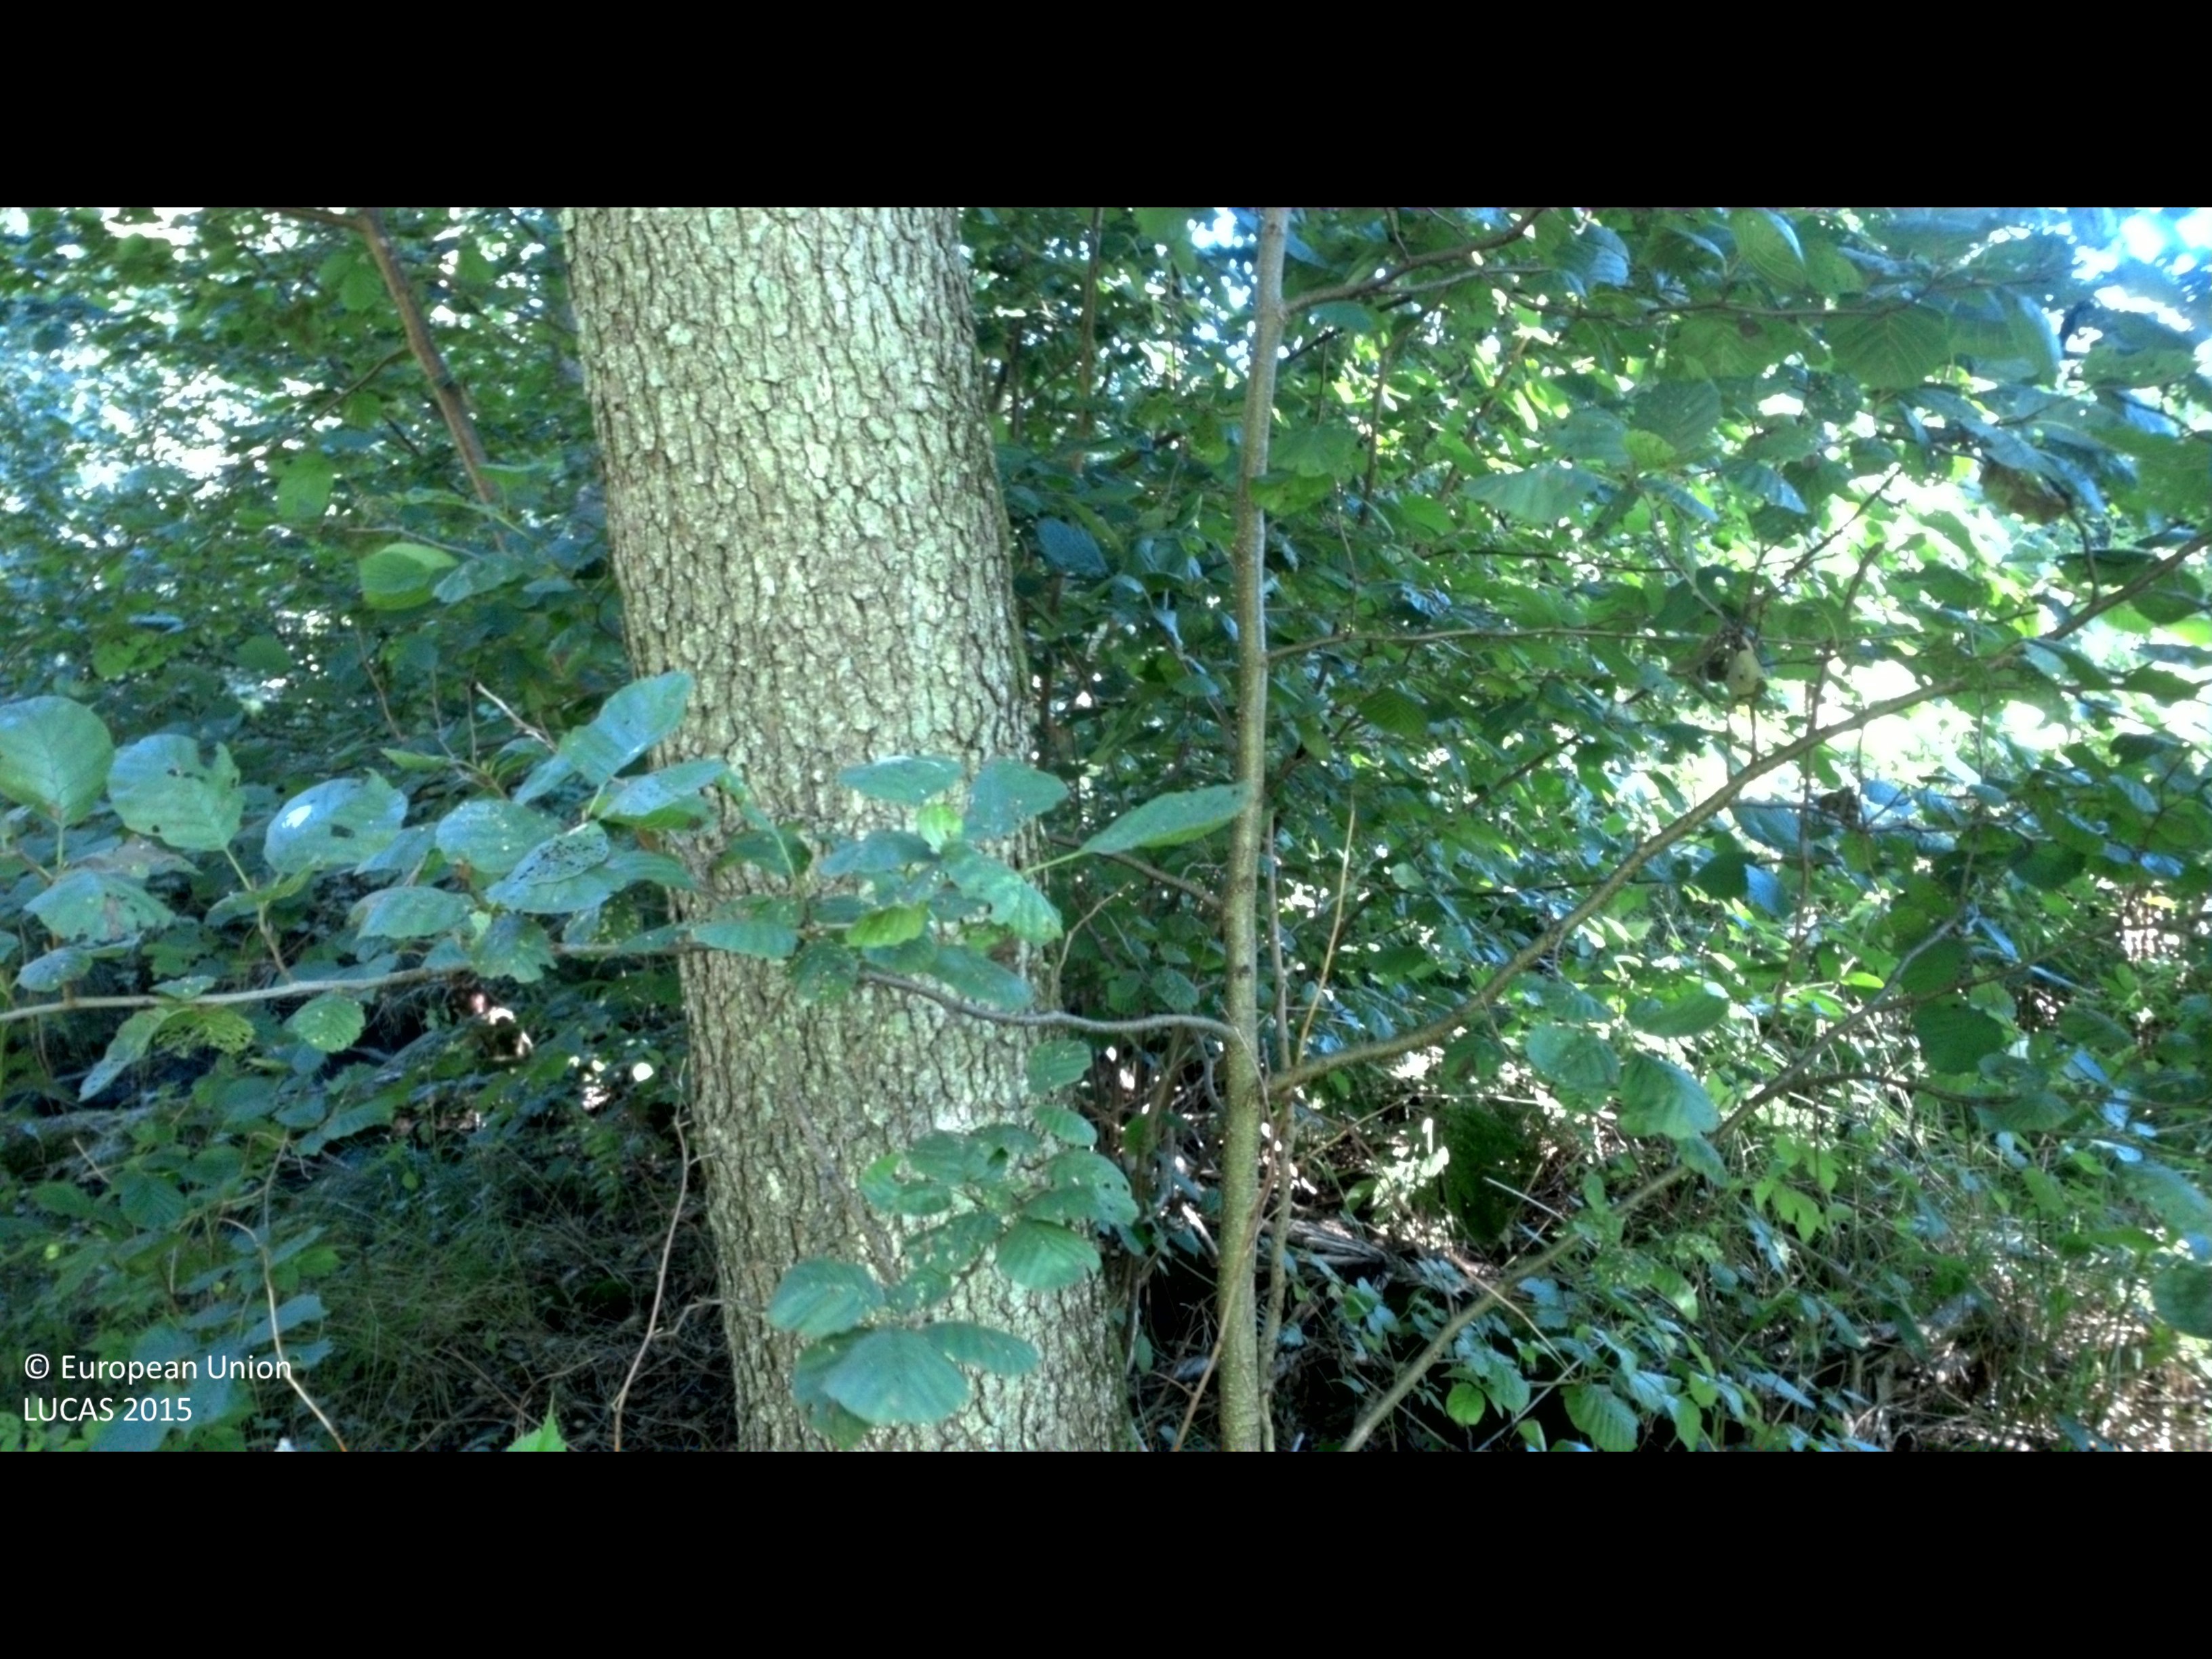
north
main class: Woodland
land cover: Broadleaved woodland
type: mire and swamp forests
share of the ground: 50 - 75 %
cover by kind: broadleaved forest trees 65 %, shrubs 25 %, herbaceous plants 10 %
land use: Forestry
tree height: > 5 m
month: September
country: SE
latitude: 56.1856
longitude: 14.3643
